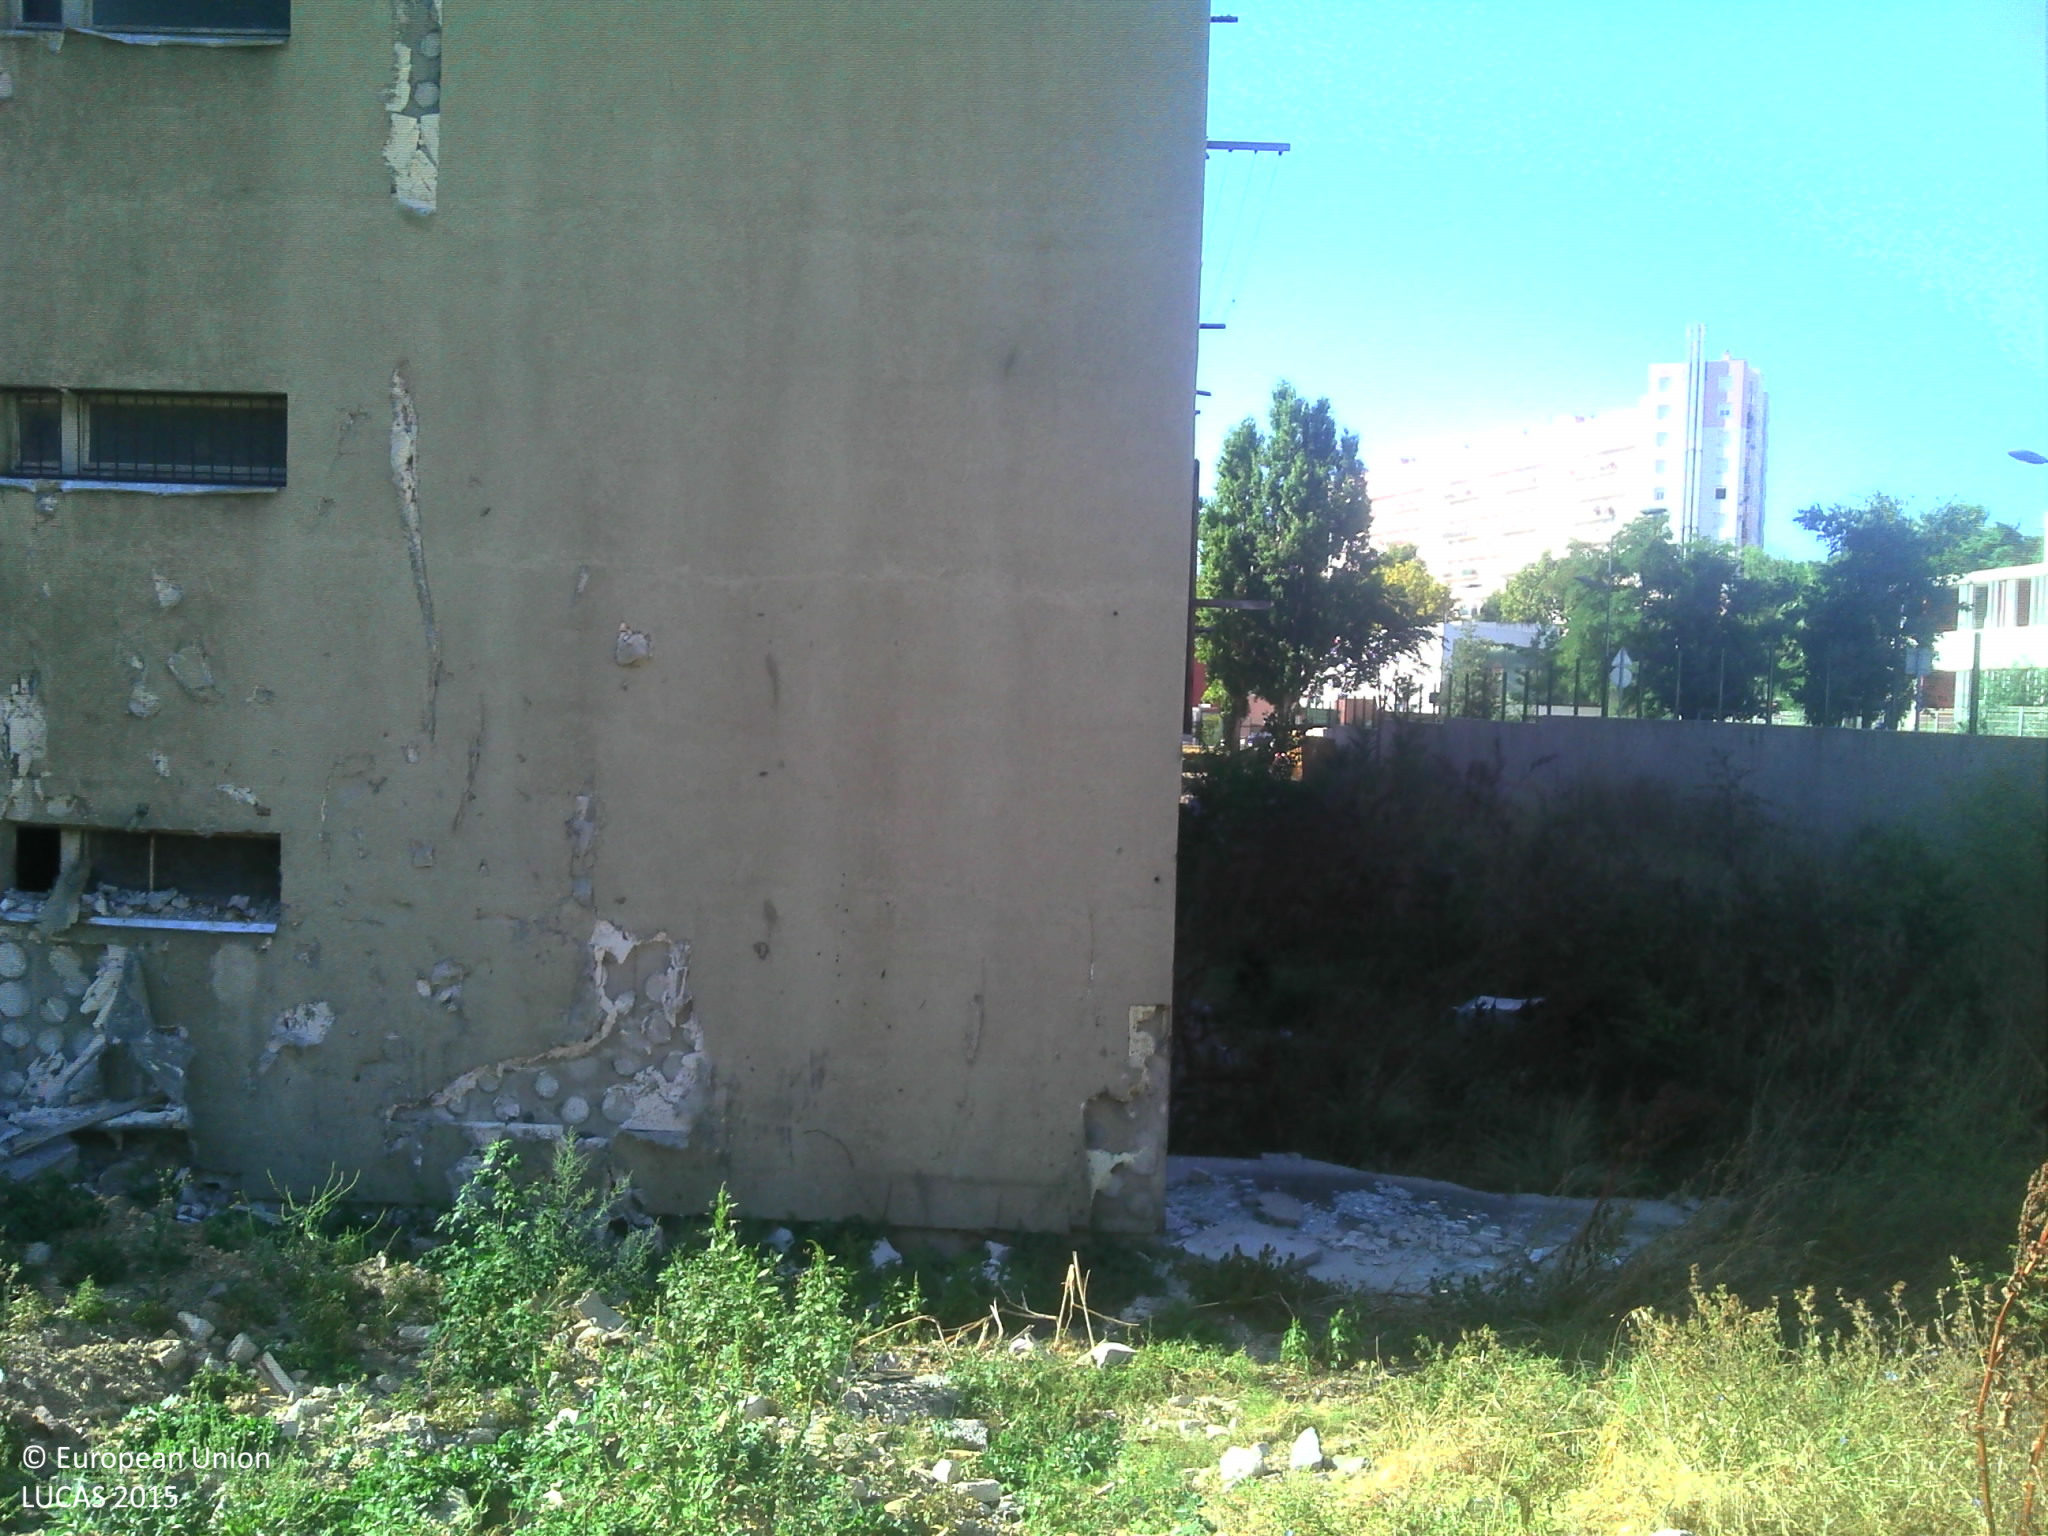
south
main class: Grassland
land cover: Grassland with sparse tree/shrub cover
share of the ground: 50 - 75 %
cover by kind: consolidated bare surface 40 %, unconsolidated bare surface 30 %, herbaceous plants 20 %, broadleaved forest trees 5 %, shrubs 5 %
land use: Abandoned areas
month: August
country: FR
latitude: 43.3275
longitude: 5.4103
